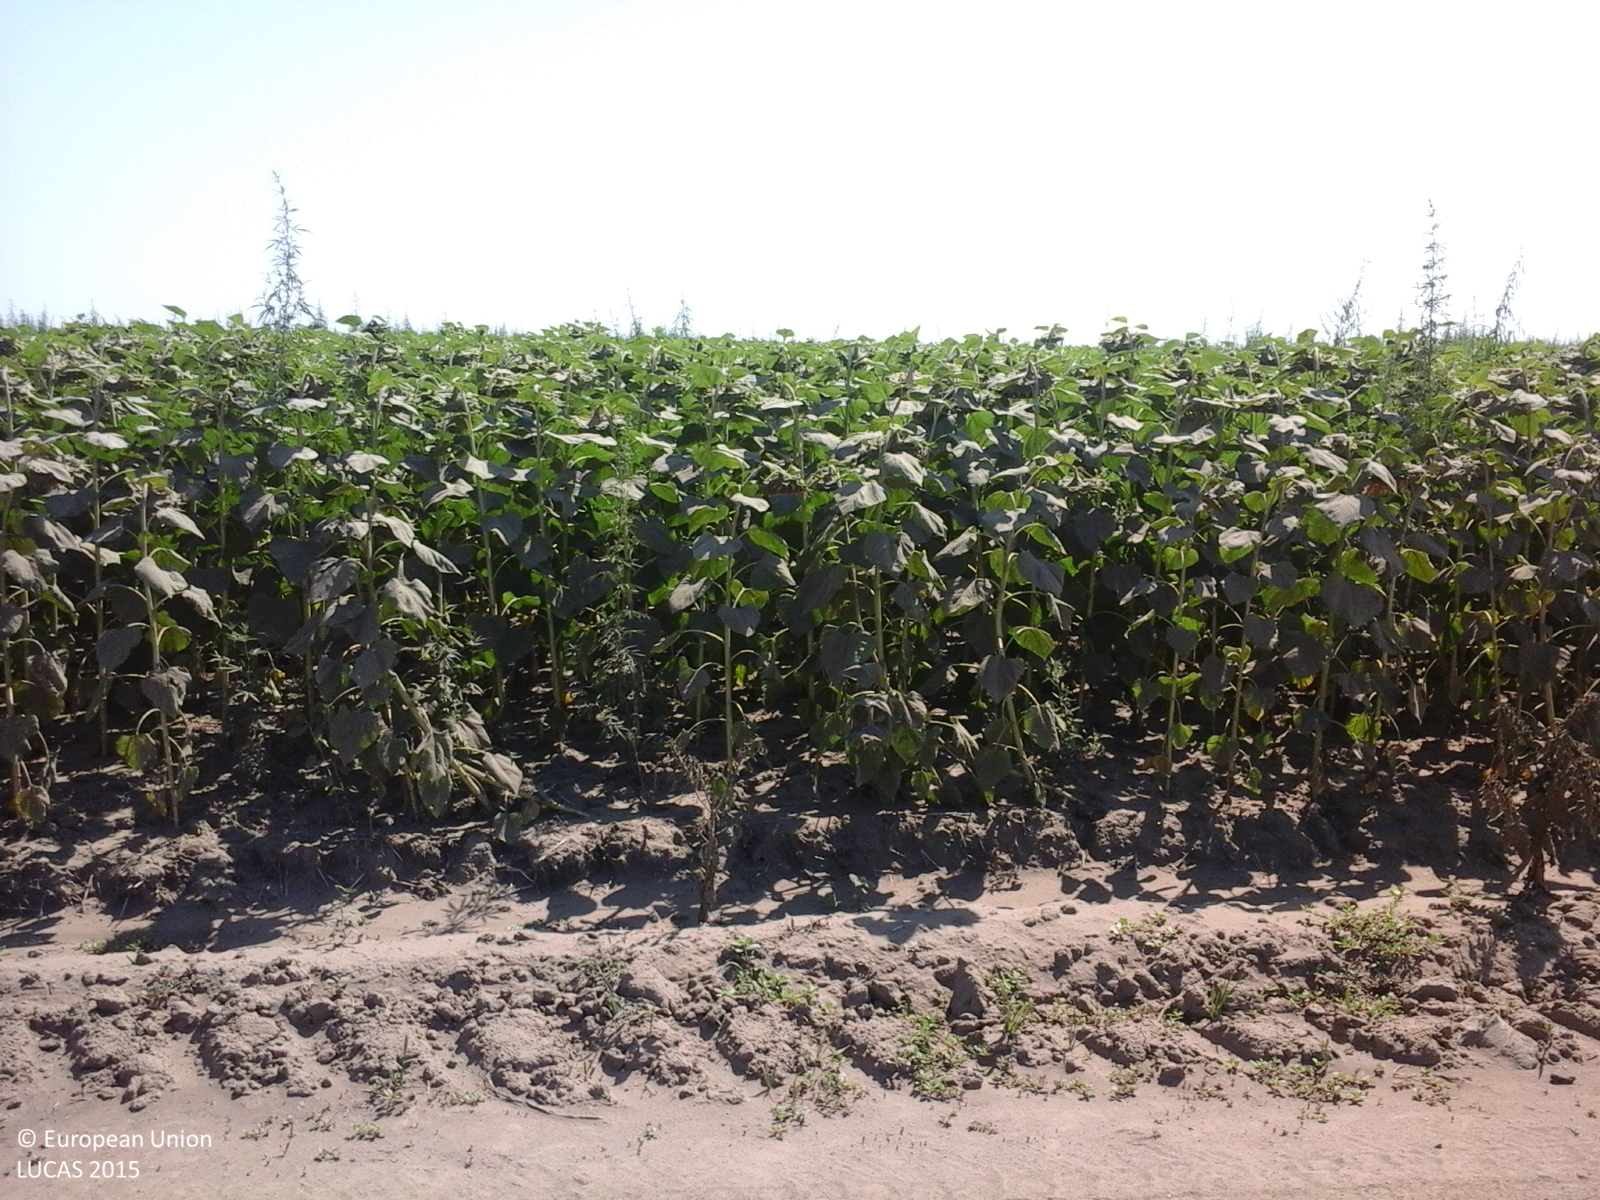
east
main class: Cropland
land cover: Sunflower
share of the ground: > 75 %
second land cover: Other fibre and oleaginous crops
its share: 50 - 75 %
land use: Agriculture (excluding fallow land and kitchen gardens)
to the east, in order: Sunflower; Other fibre and oleaginous crops
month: July
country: RO
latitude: 44.2651
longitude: 27.5153
